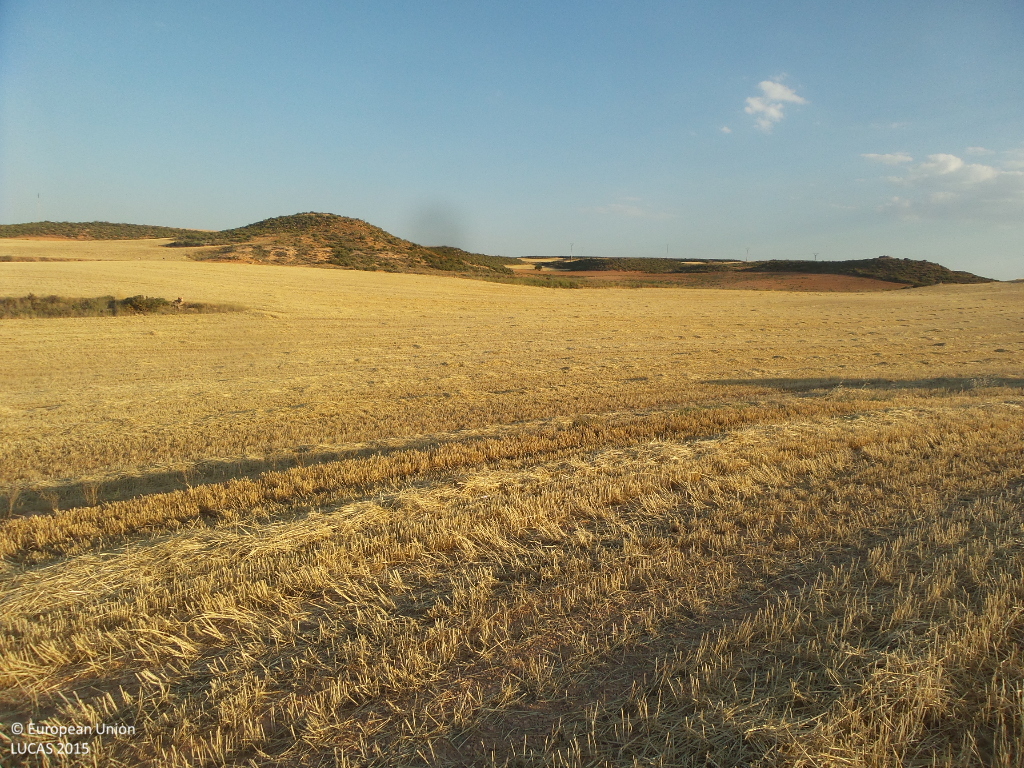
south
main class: Cropland
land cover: Barley
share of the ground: < 10 %
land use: Agriculture (excluding fallow land and kitchen gardens)
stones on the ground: < 10 %
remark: Harvested field
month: July
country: ES
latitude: 41.2812
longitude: -2.1479
